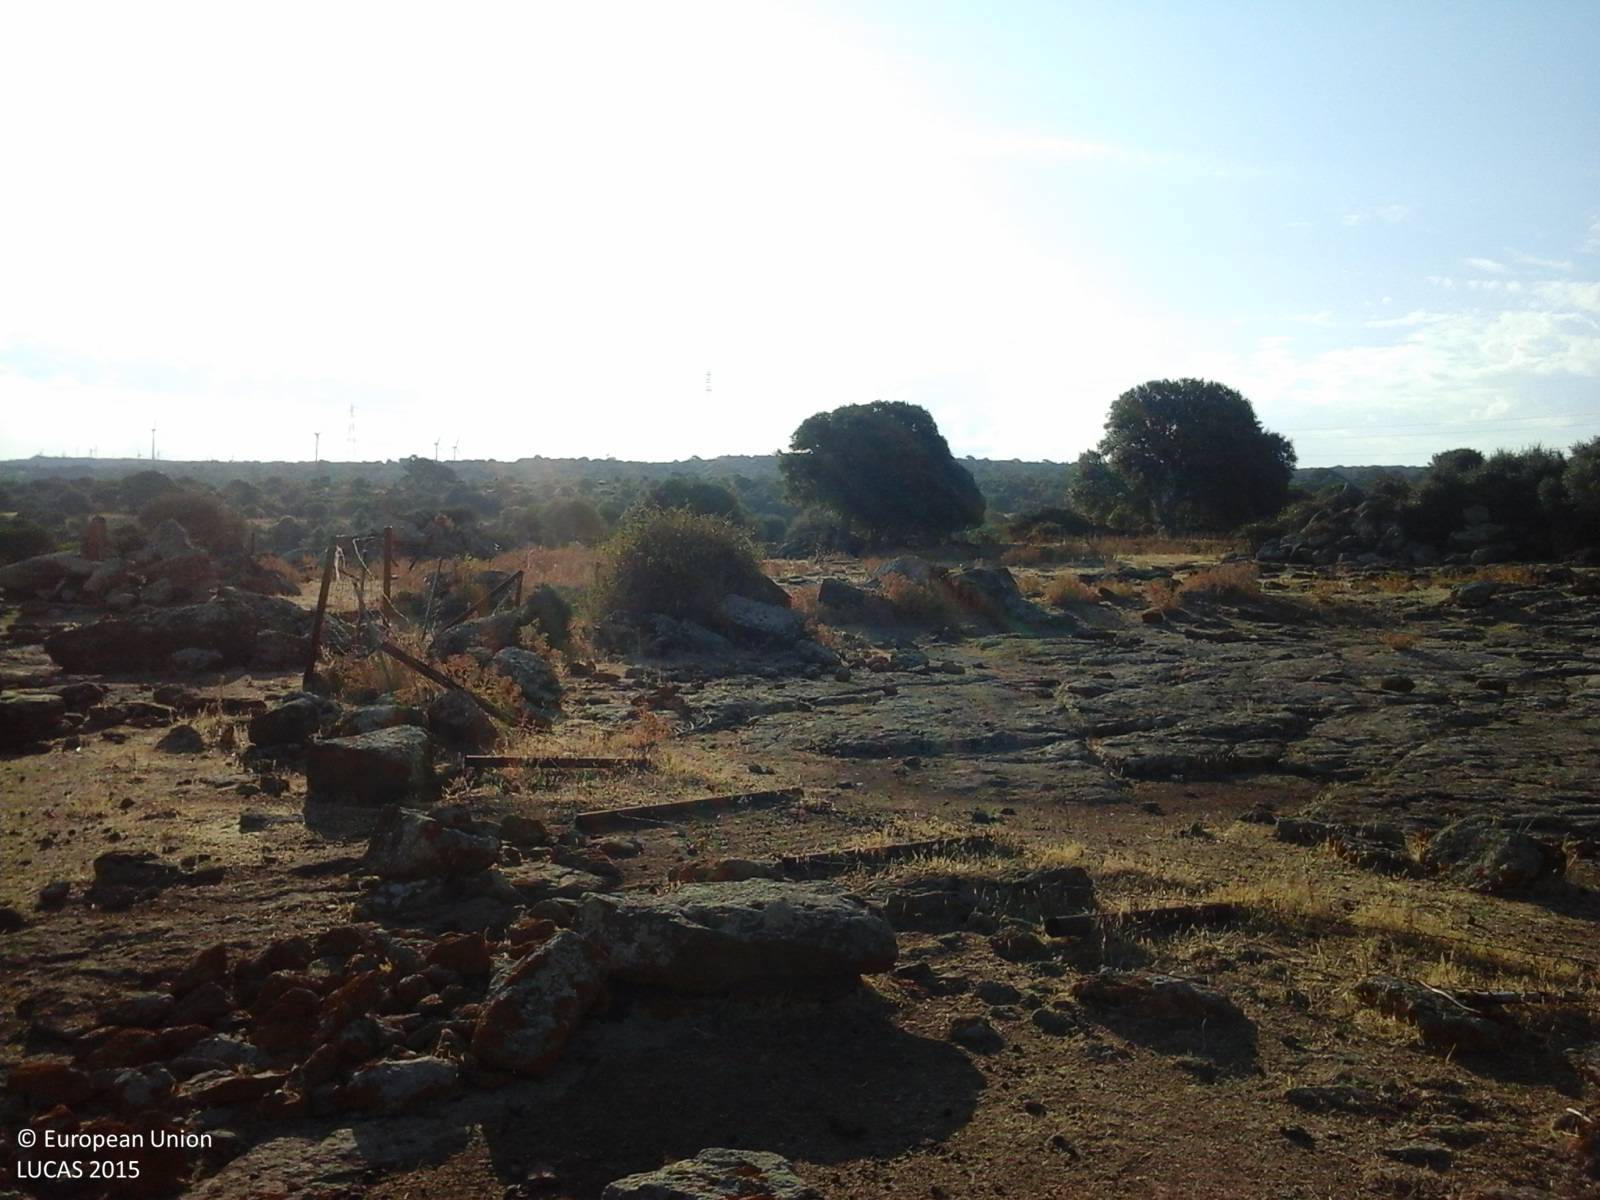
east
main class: Grassland
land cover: Grassland without tree/shrub cover
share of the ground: < 10 %
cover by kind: consolidated bare surface 80 %, herbaceous plants 20 %
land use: Agriculture (excluding fallow land and kitchen gardens)
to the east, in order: Grassland without tree/shrub cover; Rock outcrops; Grassland without tree/shrub cover; Fences; Grassland with sparse tree/shrub cover; Dry stone walls; Fences; Grassland without tree/shrub cover; Abandoned hedges; Grassland with sparse tree/shrub cover
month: July
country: IT
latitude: 40.7499
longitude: 8.9038
